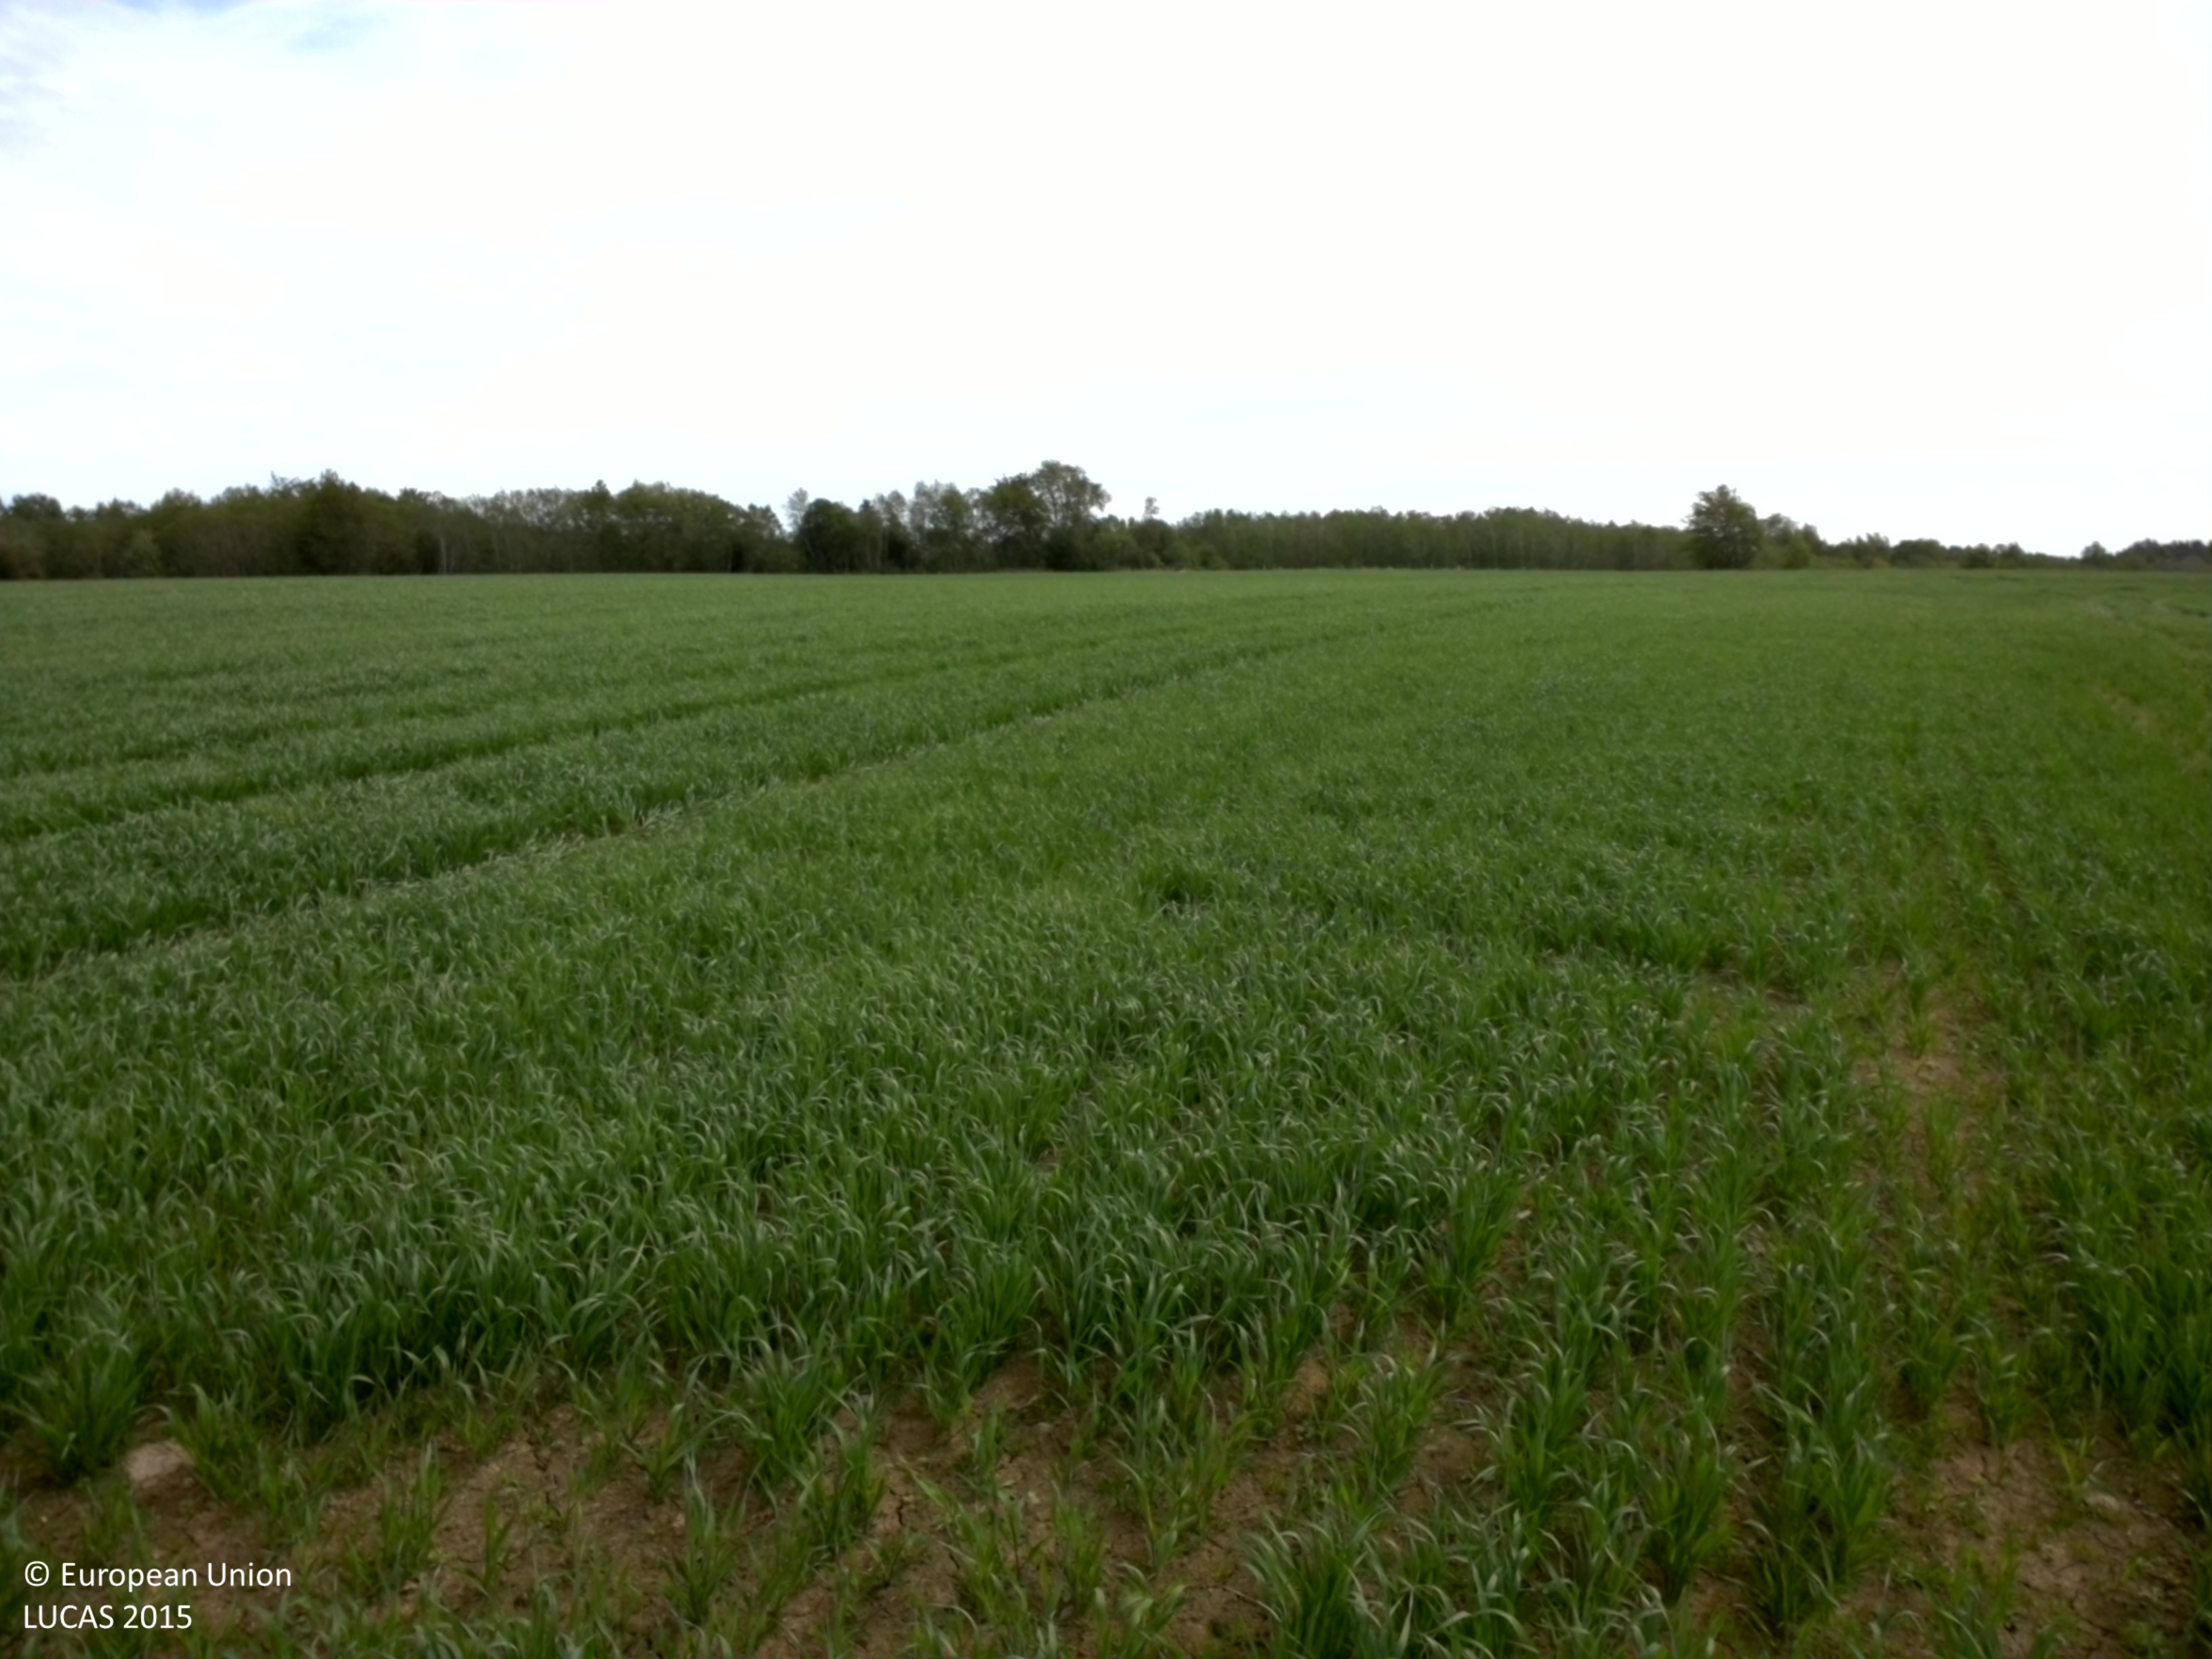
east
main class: Cropland
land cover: Oats
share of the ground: > 75 %
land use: Agriculture (excluding fallow land and kitchen gardens)
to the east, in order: Oats; Grass margins; Broadleaved woodland; Fences; Broadleaved woodland; Grassland without tree/shrub cover; Shrubland without tree cover; Grassland without tree/shrub cover
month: June
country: SE
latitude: 58.4147
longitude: 13.9137
